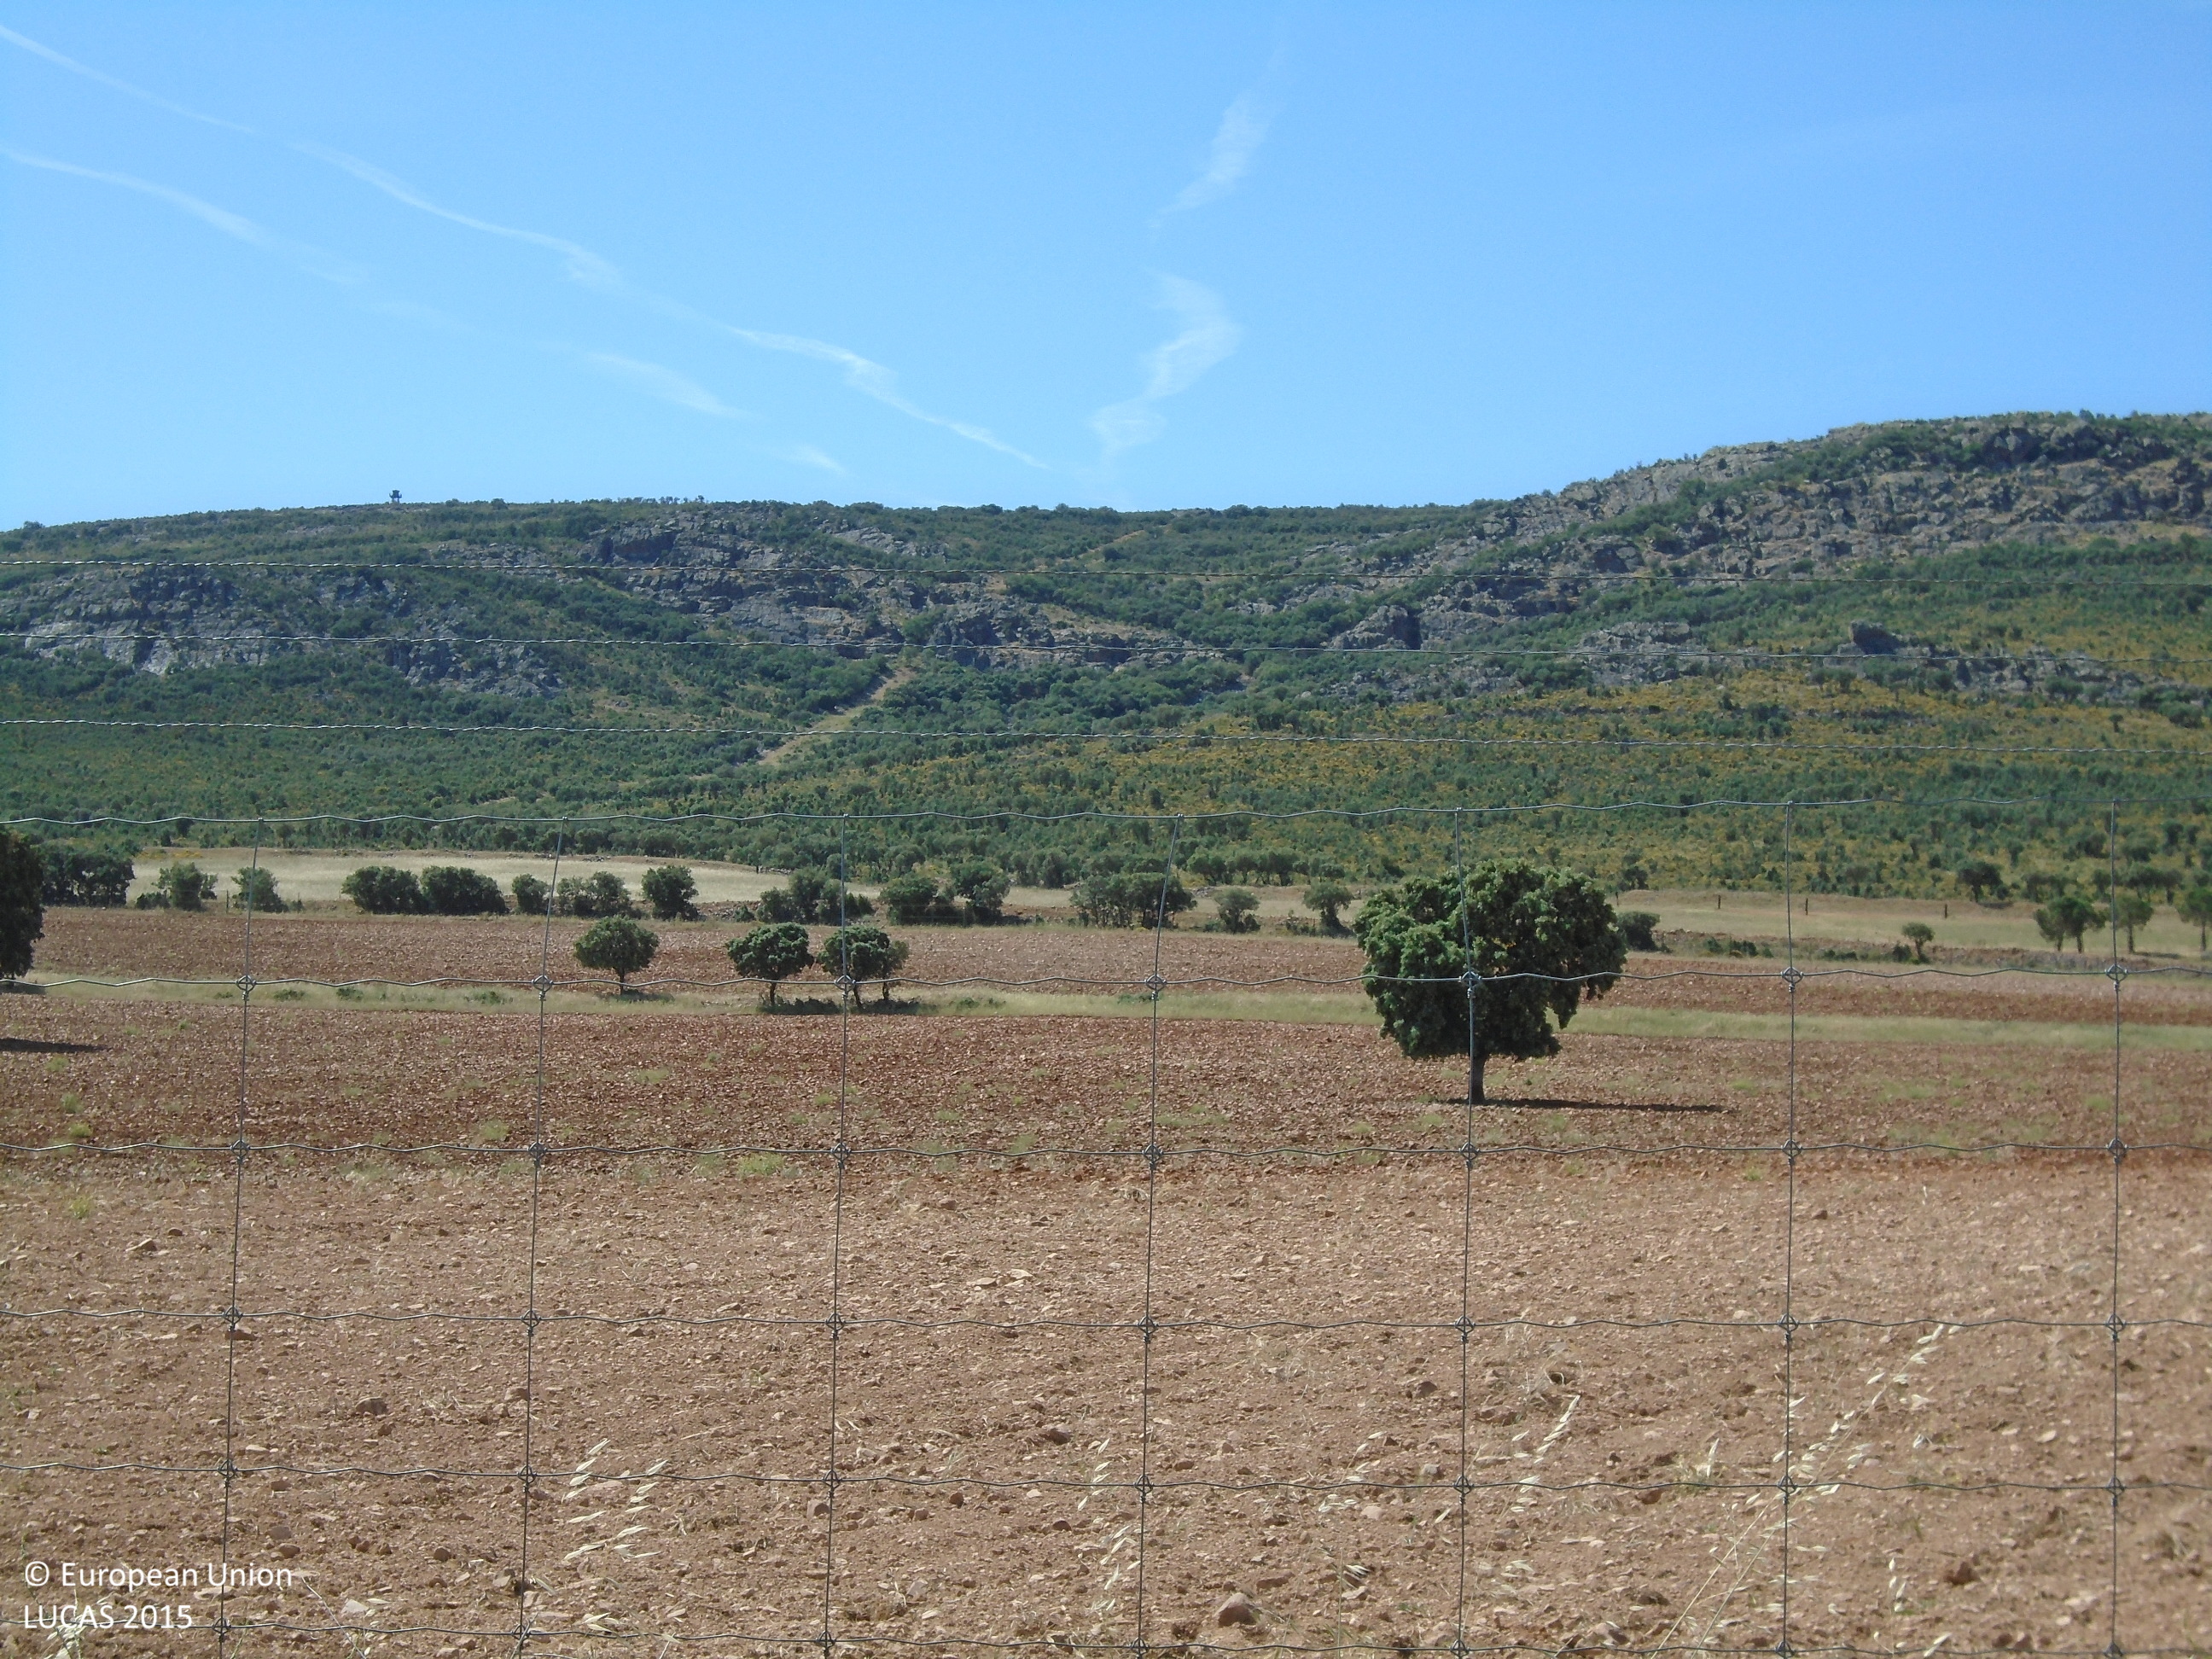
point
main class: Woodland
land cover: Broadleaved woodland
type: broadleaved evergreen forest
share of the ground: > 75 %
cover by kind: broadleaved forest trees 60 %, shrubs 30 %, herbaceous plants 5 %, consolidated bare surface 5 %
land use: Other primary production
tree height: > 5 m
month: May
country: ES
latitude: 39.4622
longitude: -3.7280
